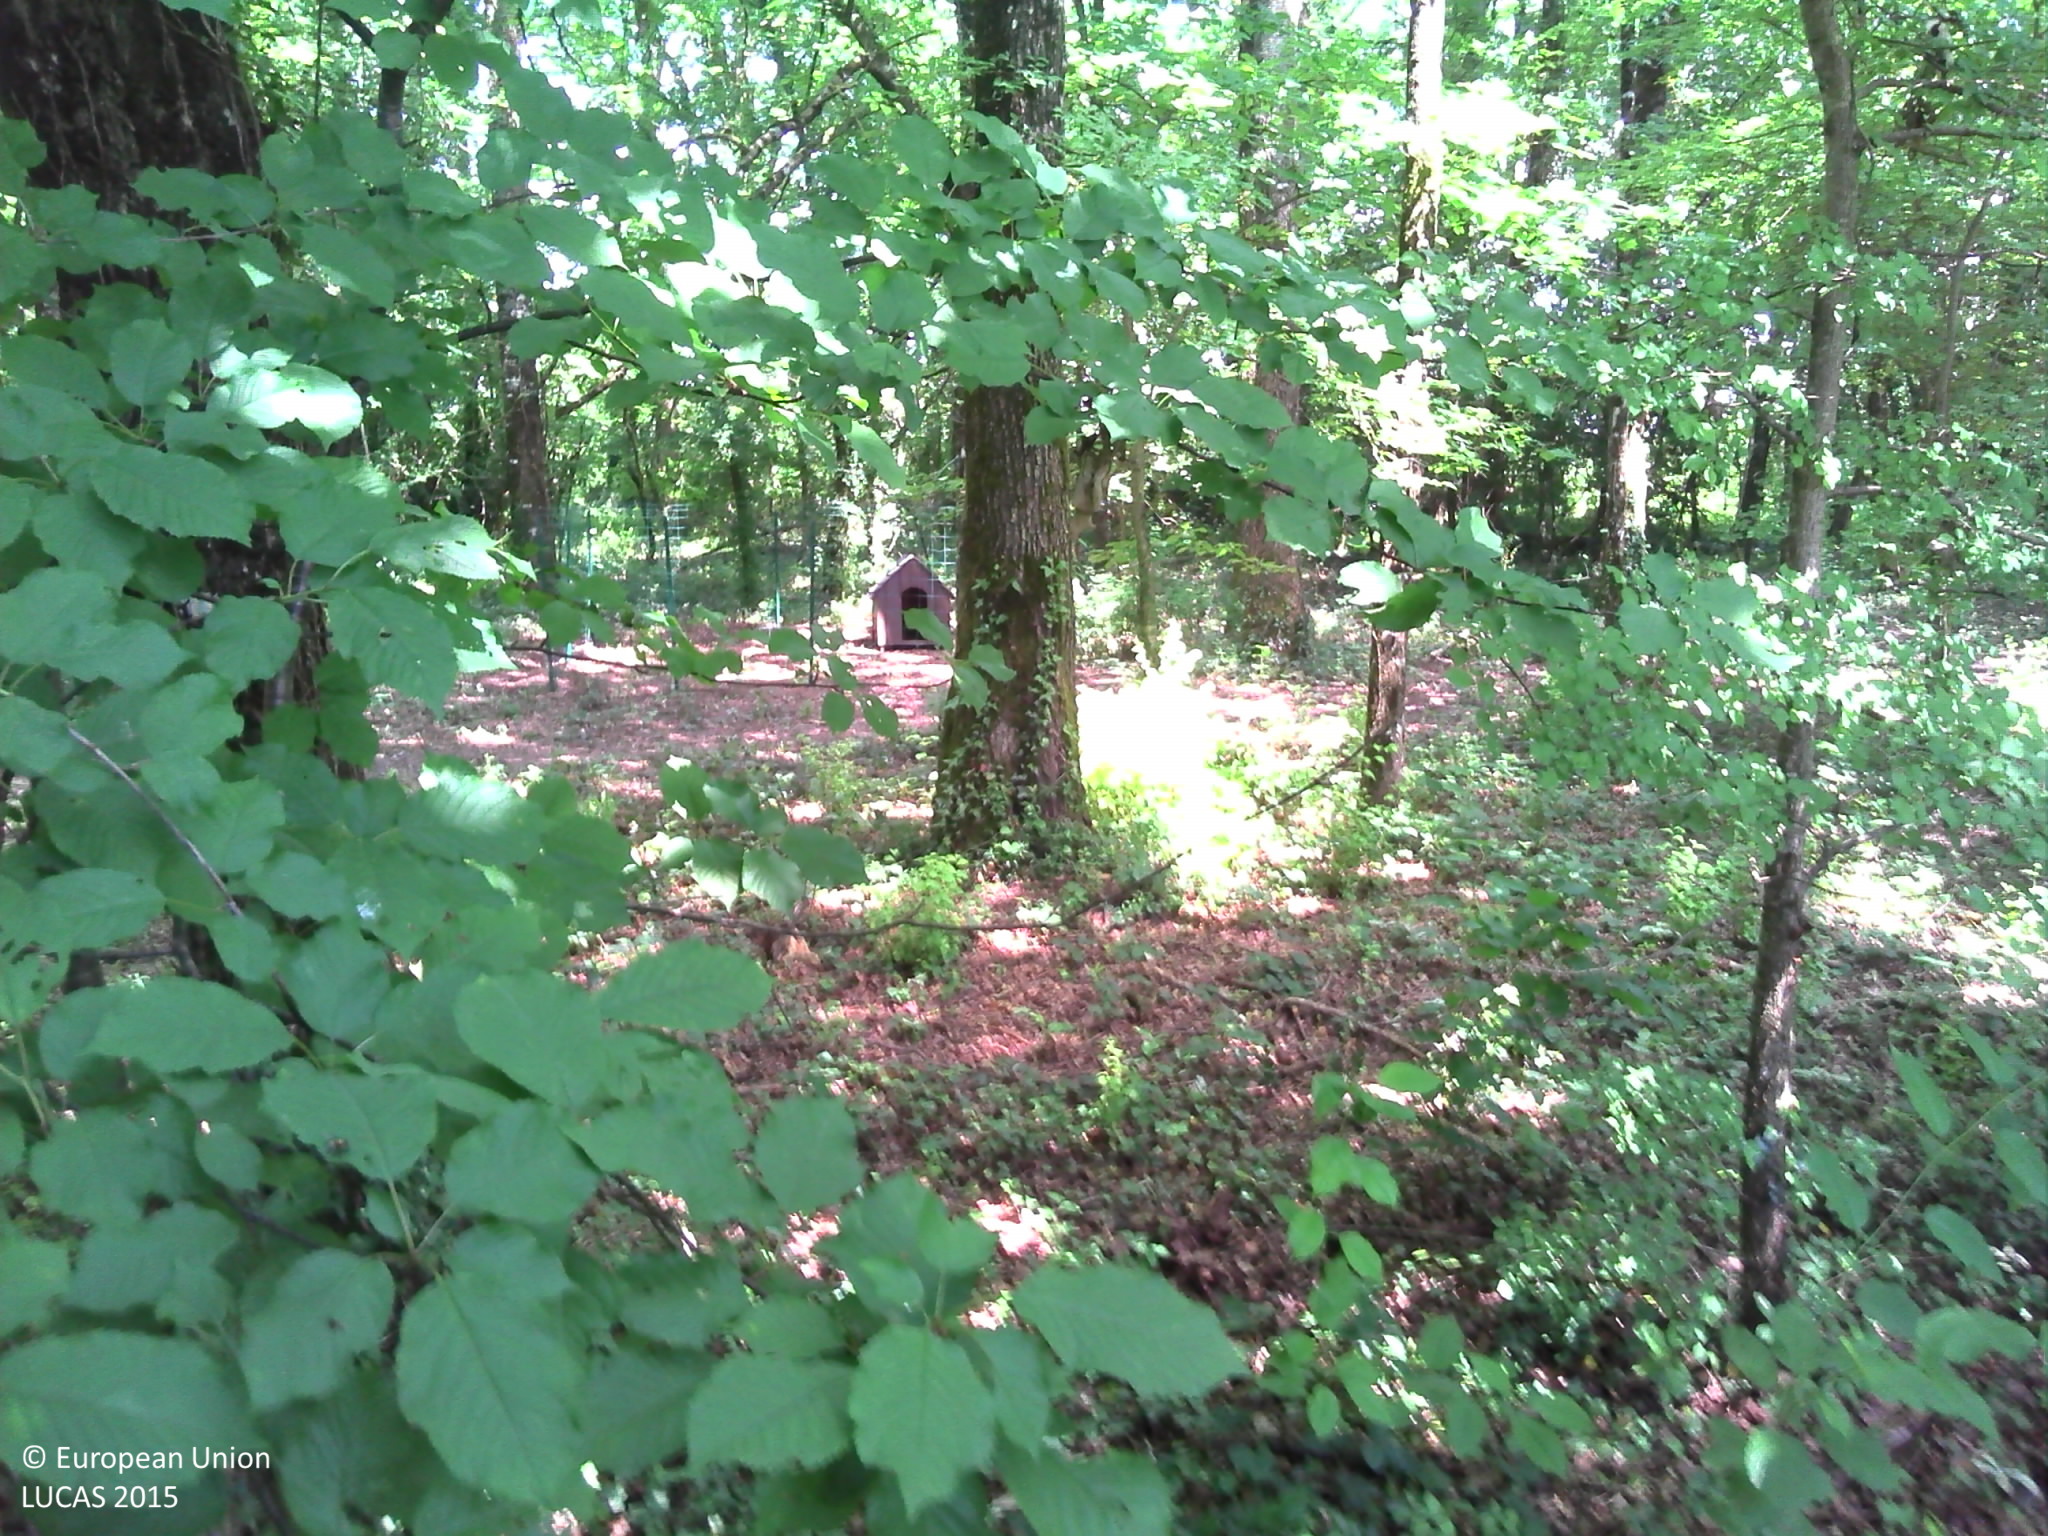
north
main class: Woodland
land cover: Broadleaved woodland
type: mesophytic deciduous forest
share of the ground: > 75 %
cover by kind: broadleaved forest trees 95 %, herbaceous plants 5 %
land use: Forestry
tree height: > 5 m
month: June
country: FR
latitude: 46.5395
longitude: 0.4500
